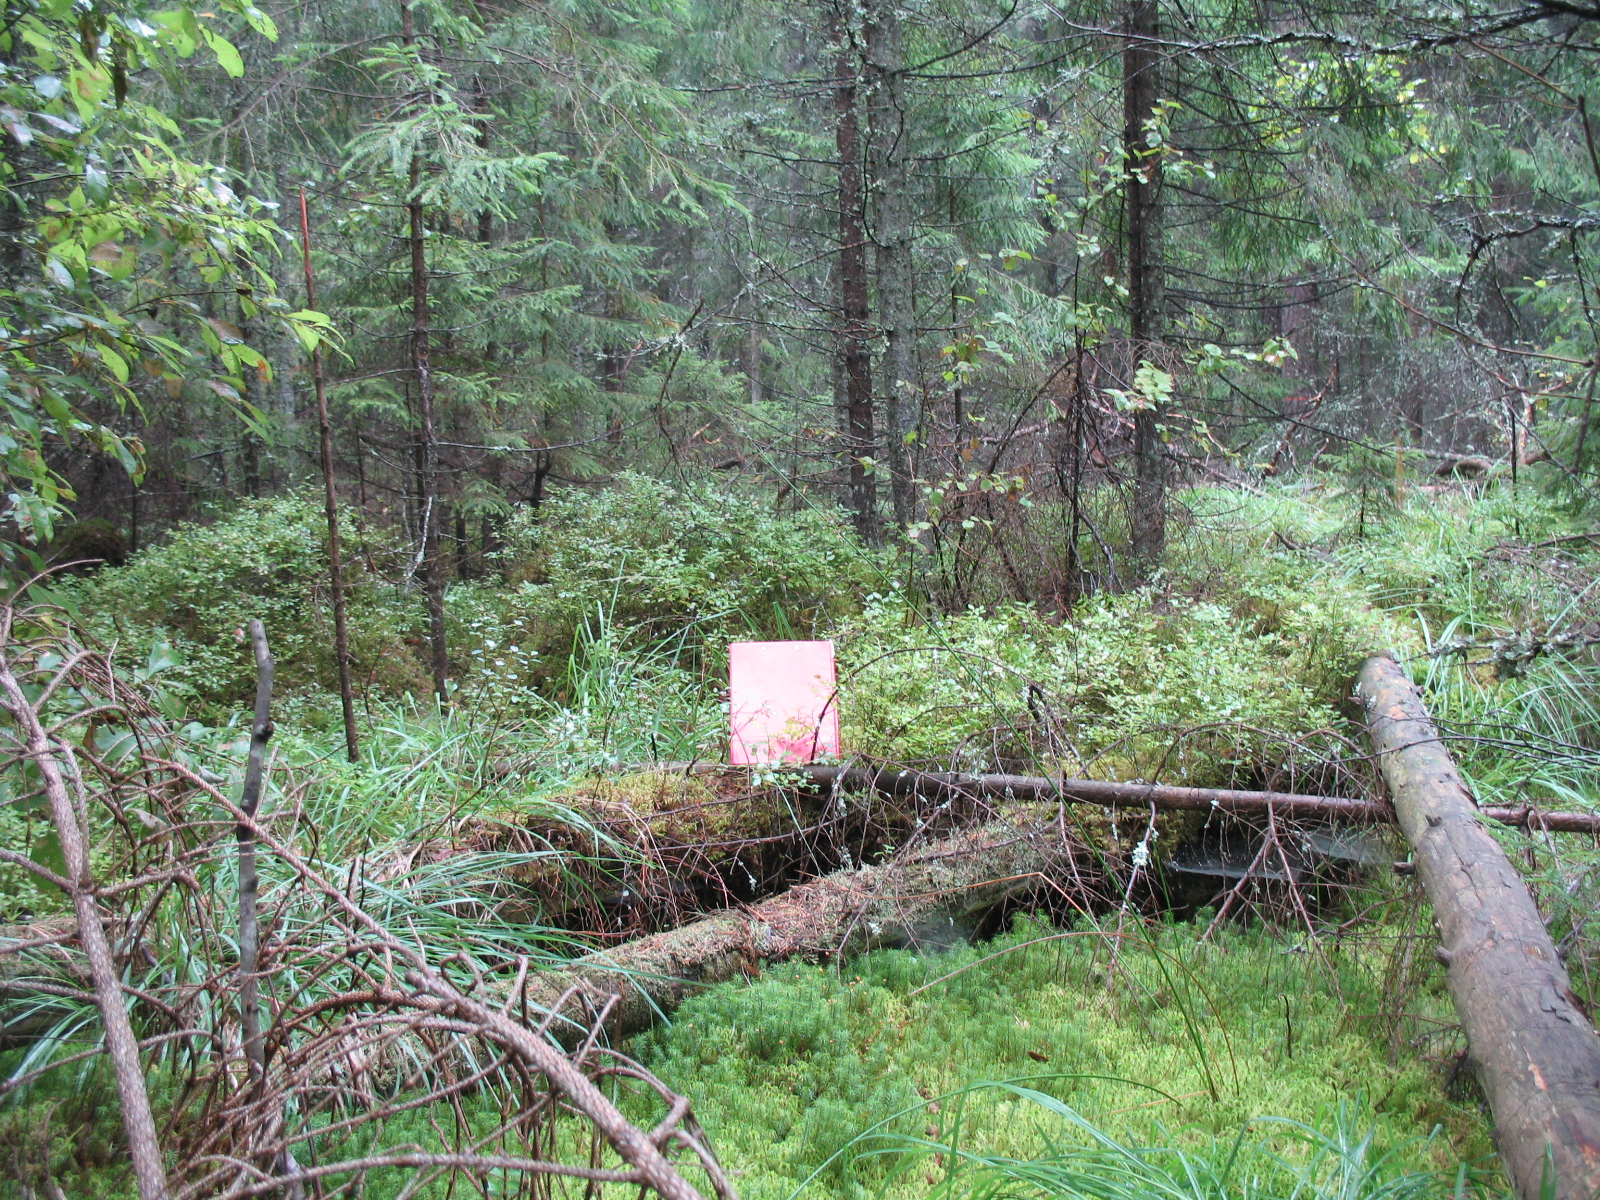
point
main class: Woodland
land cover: Other coniferous woodland
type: hemiboreal forest and nemoral coniferous forest and mixed broadleaved-coniferous forest
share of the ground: > 75 %
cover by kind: coniferous forest trees 75 %, herbaceous plants 10 %, lichens and mosses 10 %, shrubs 5 %
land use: Forestry
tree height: > 5 m
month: September
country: LV
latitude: 56.1305
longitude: 26.2805
